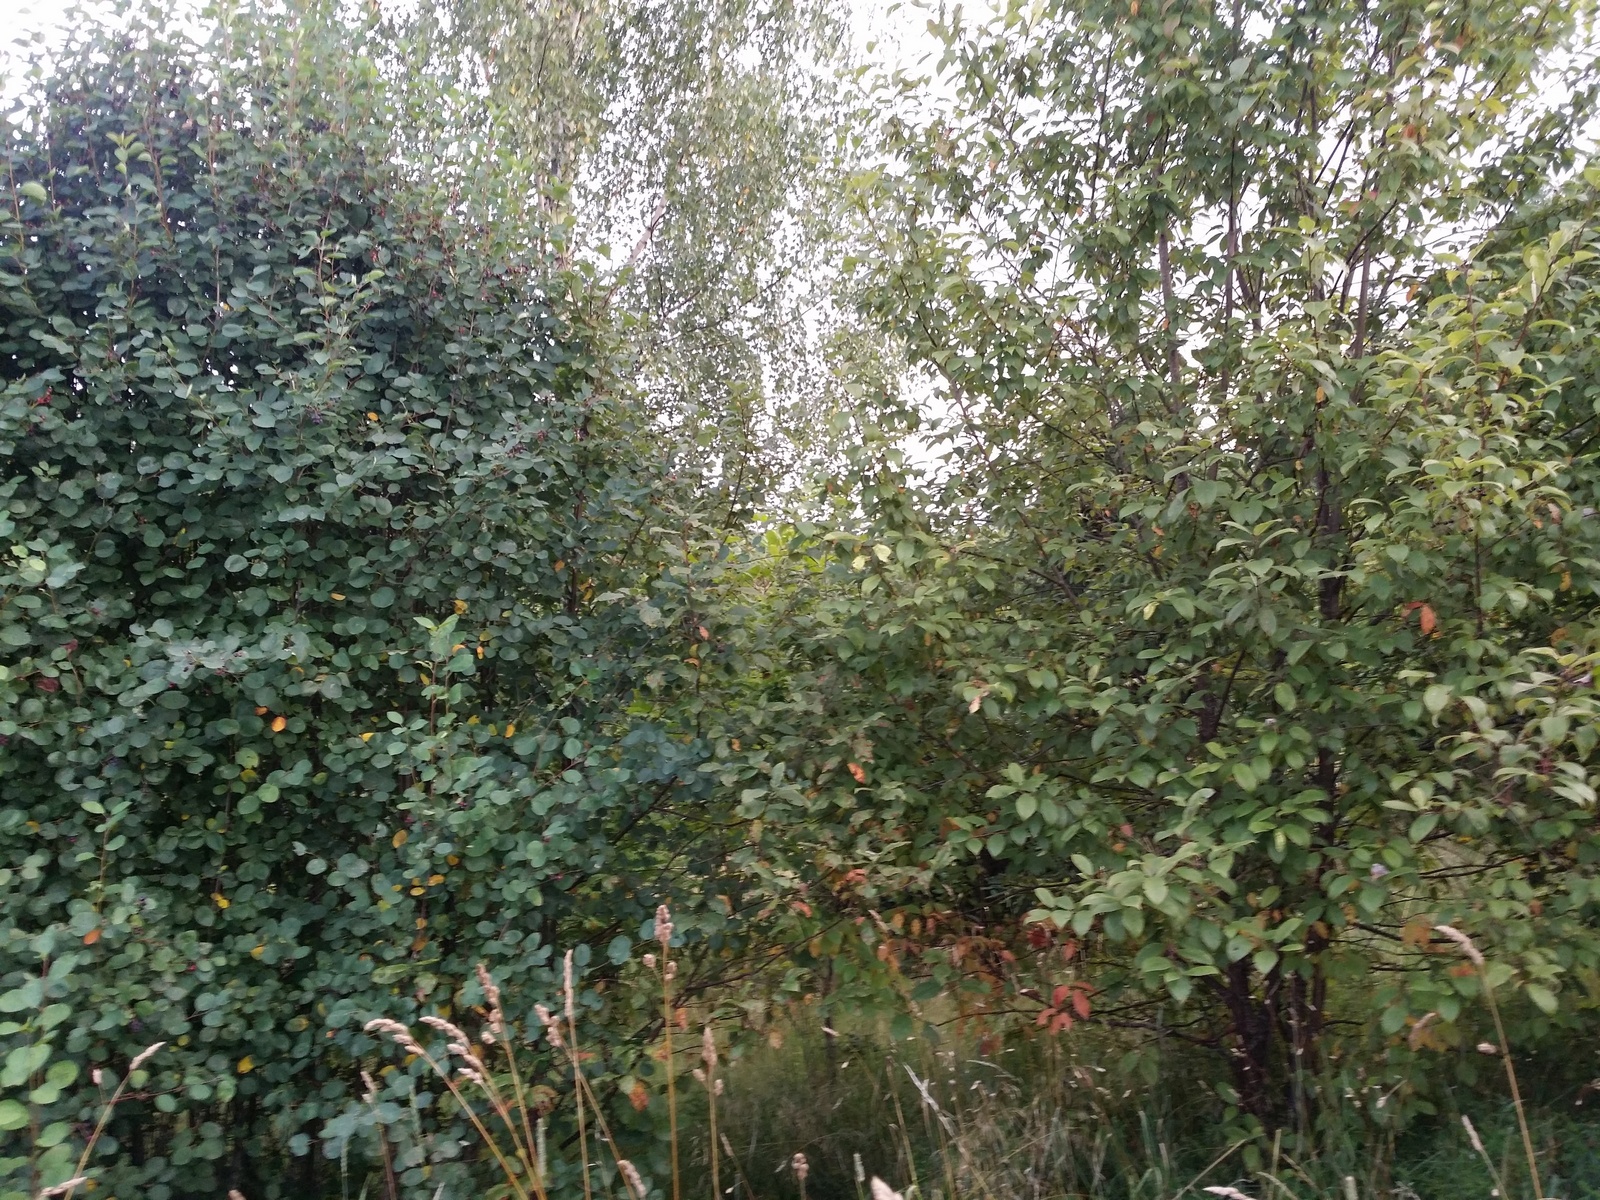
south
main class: Grassland
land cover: Spontaneously vegetated surfaces
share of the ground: > 75 %
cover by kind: herbaceous plants 100 %
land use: Semi-natural and natural areas not in use
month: August
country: LV
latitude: 57.3499
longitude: 26.8220
